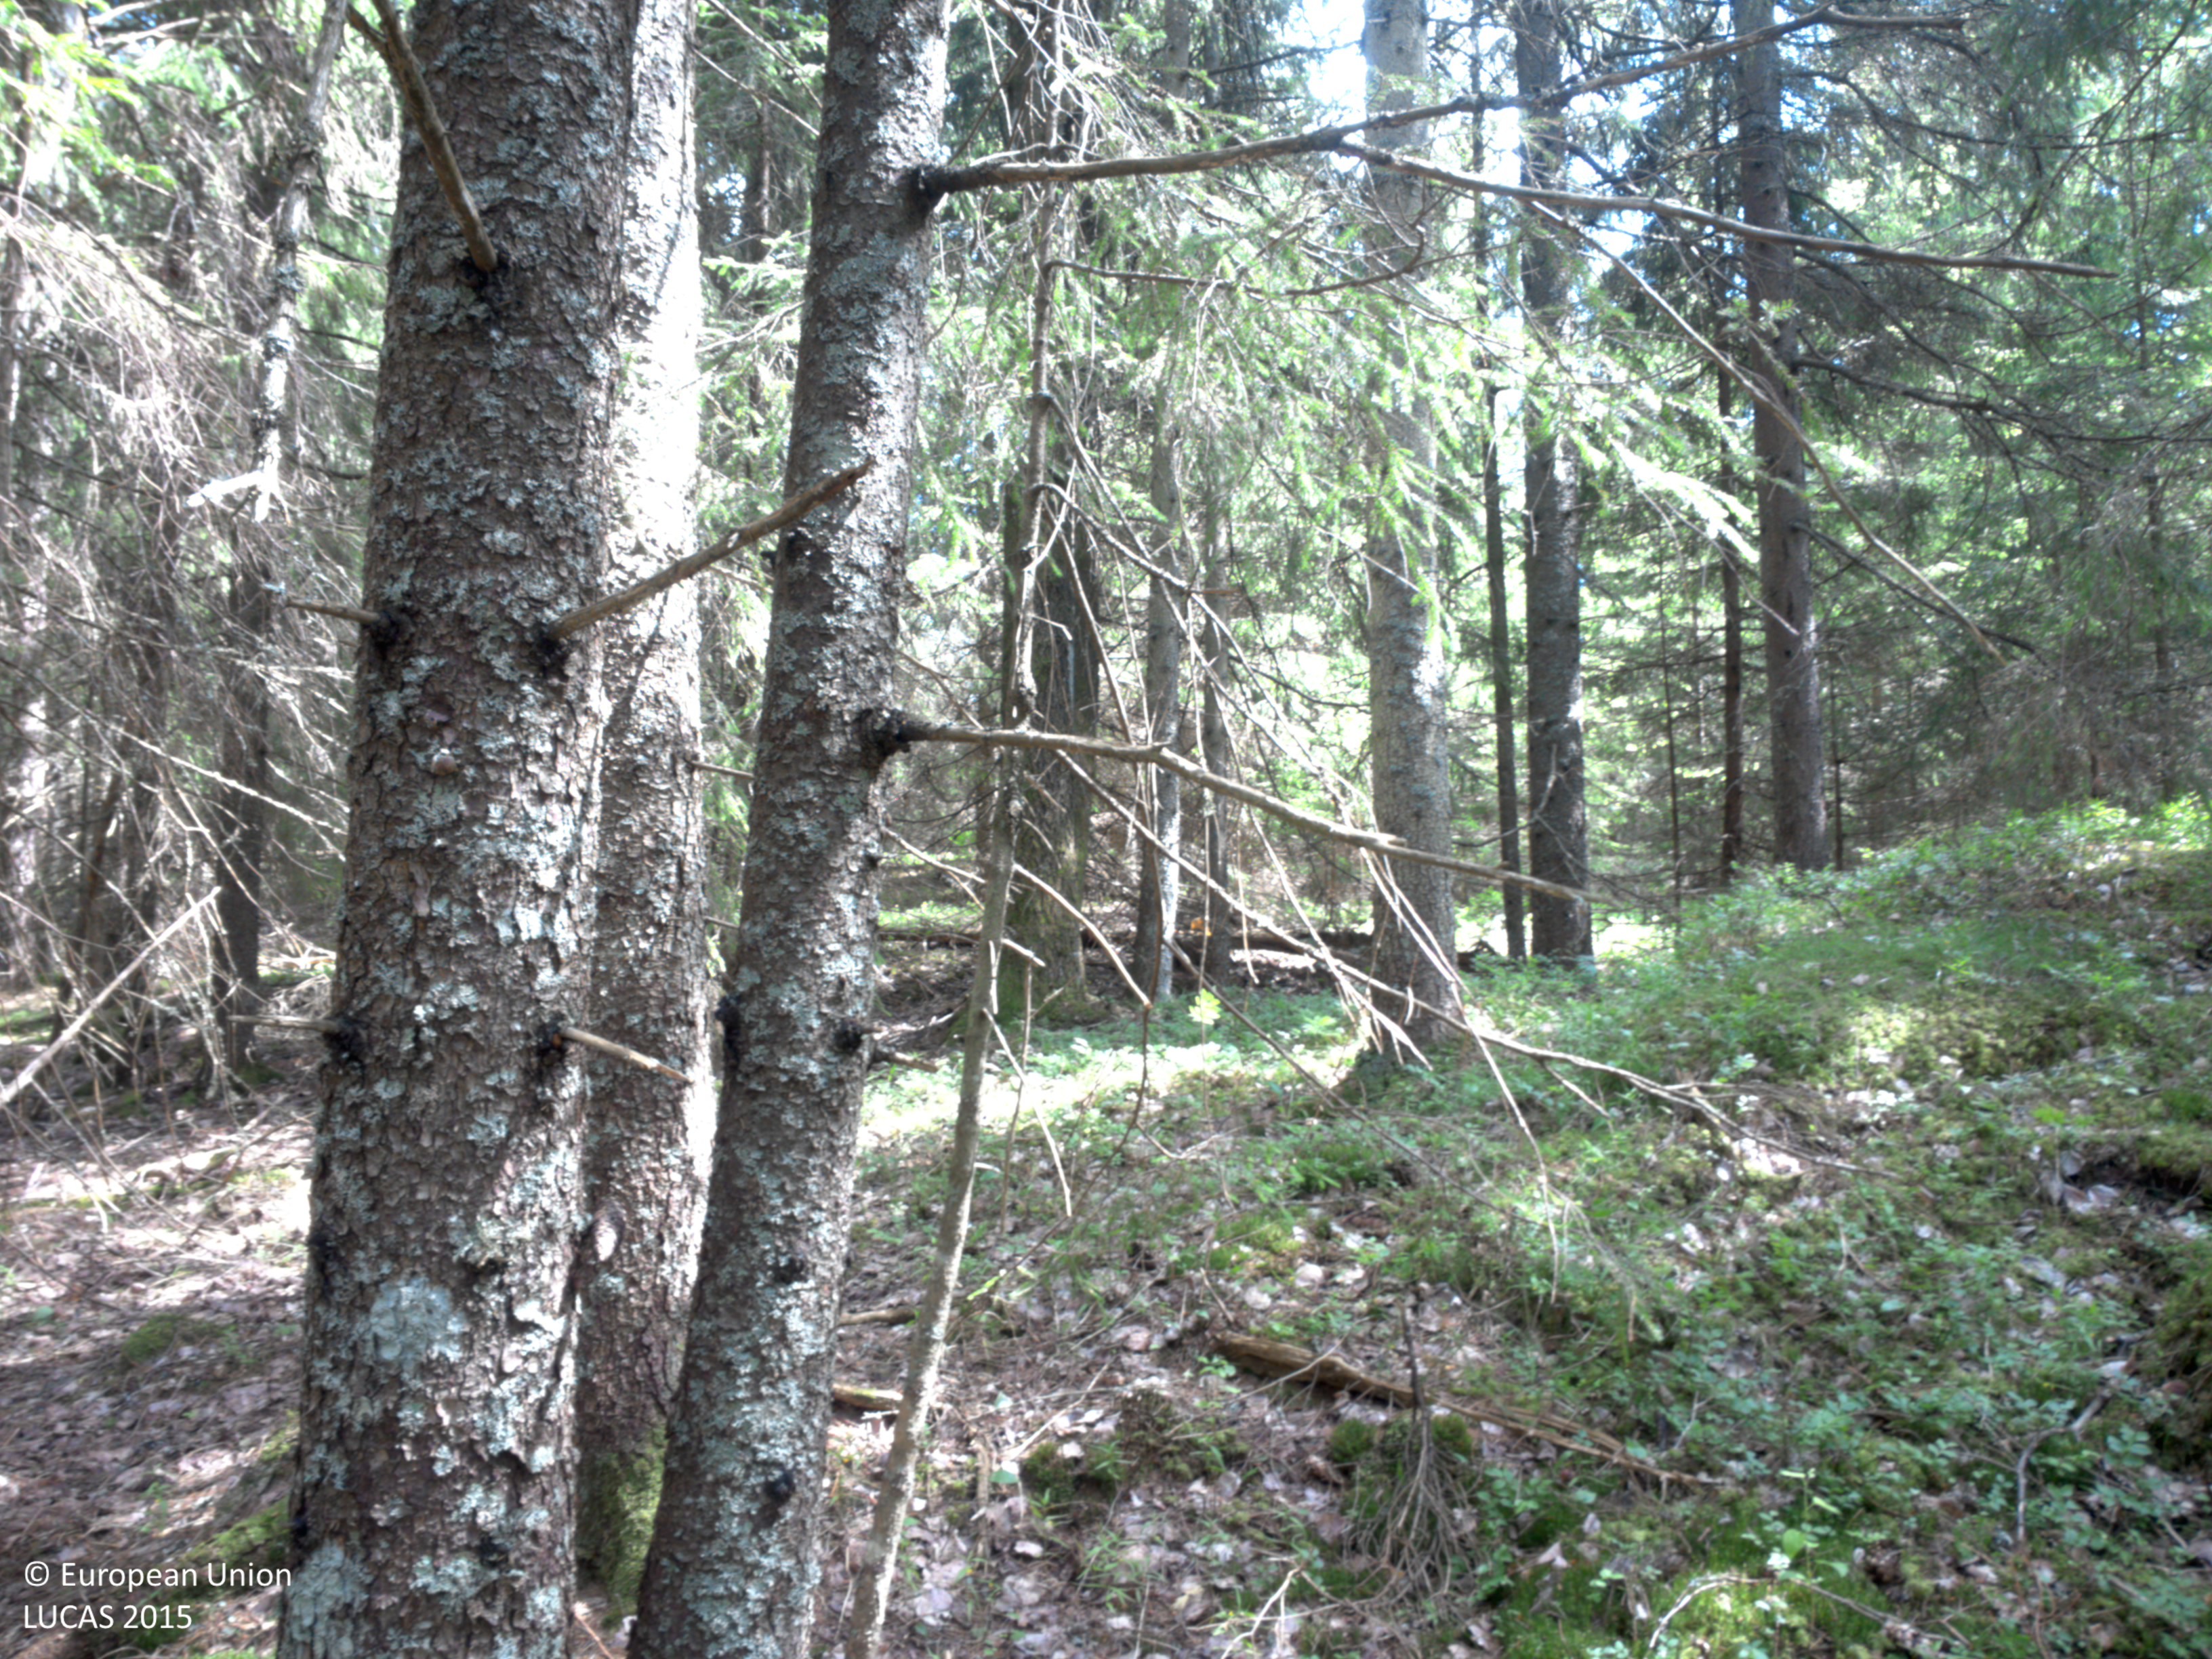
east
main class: Woodland
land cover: Spruce dominated coniferous woodland
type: boreal forest
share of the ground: 50 - 75 %
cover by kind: coniferous forest trees 65 %, lichens and mosses 20 %, shrubs 15 %
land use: Forestry
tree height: > 5 m
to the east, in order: Spruce dominated coniferous woodland; Ditches and canals; Spruce dominated coniferous woodland; Ditches and canals; Spruce dominated coniferous woodland
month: July
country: SE
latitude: 58.7991
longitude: 11.9513
